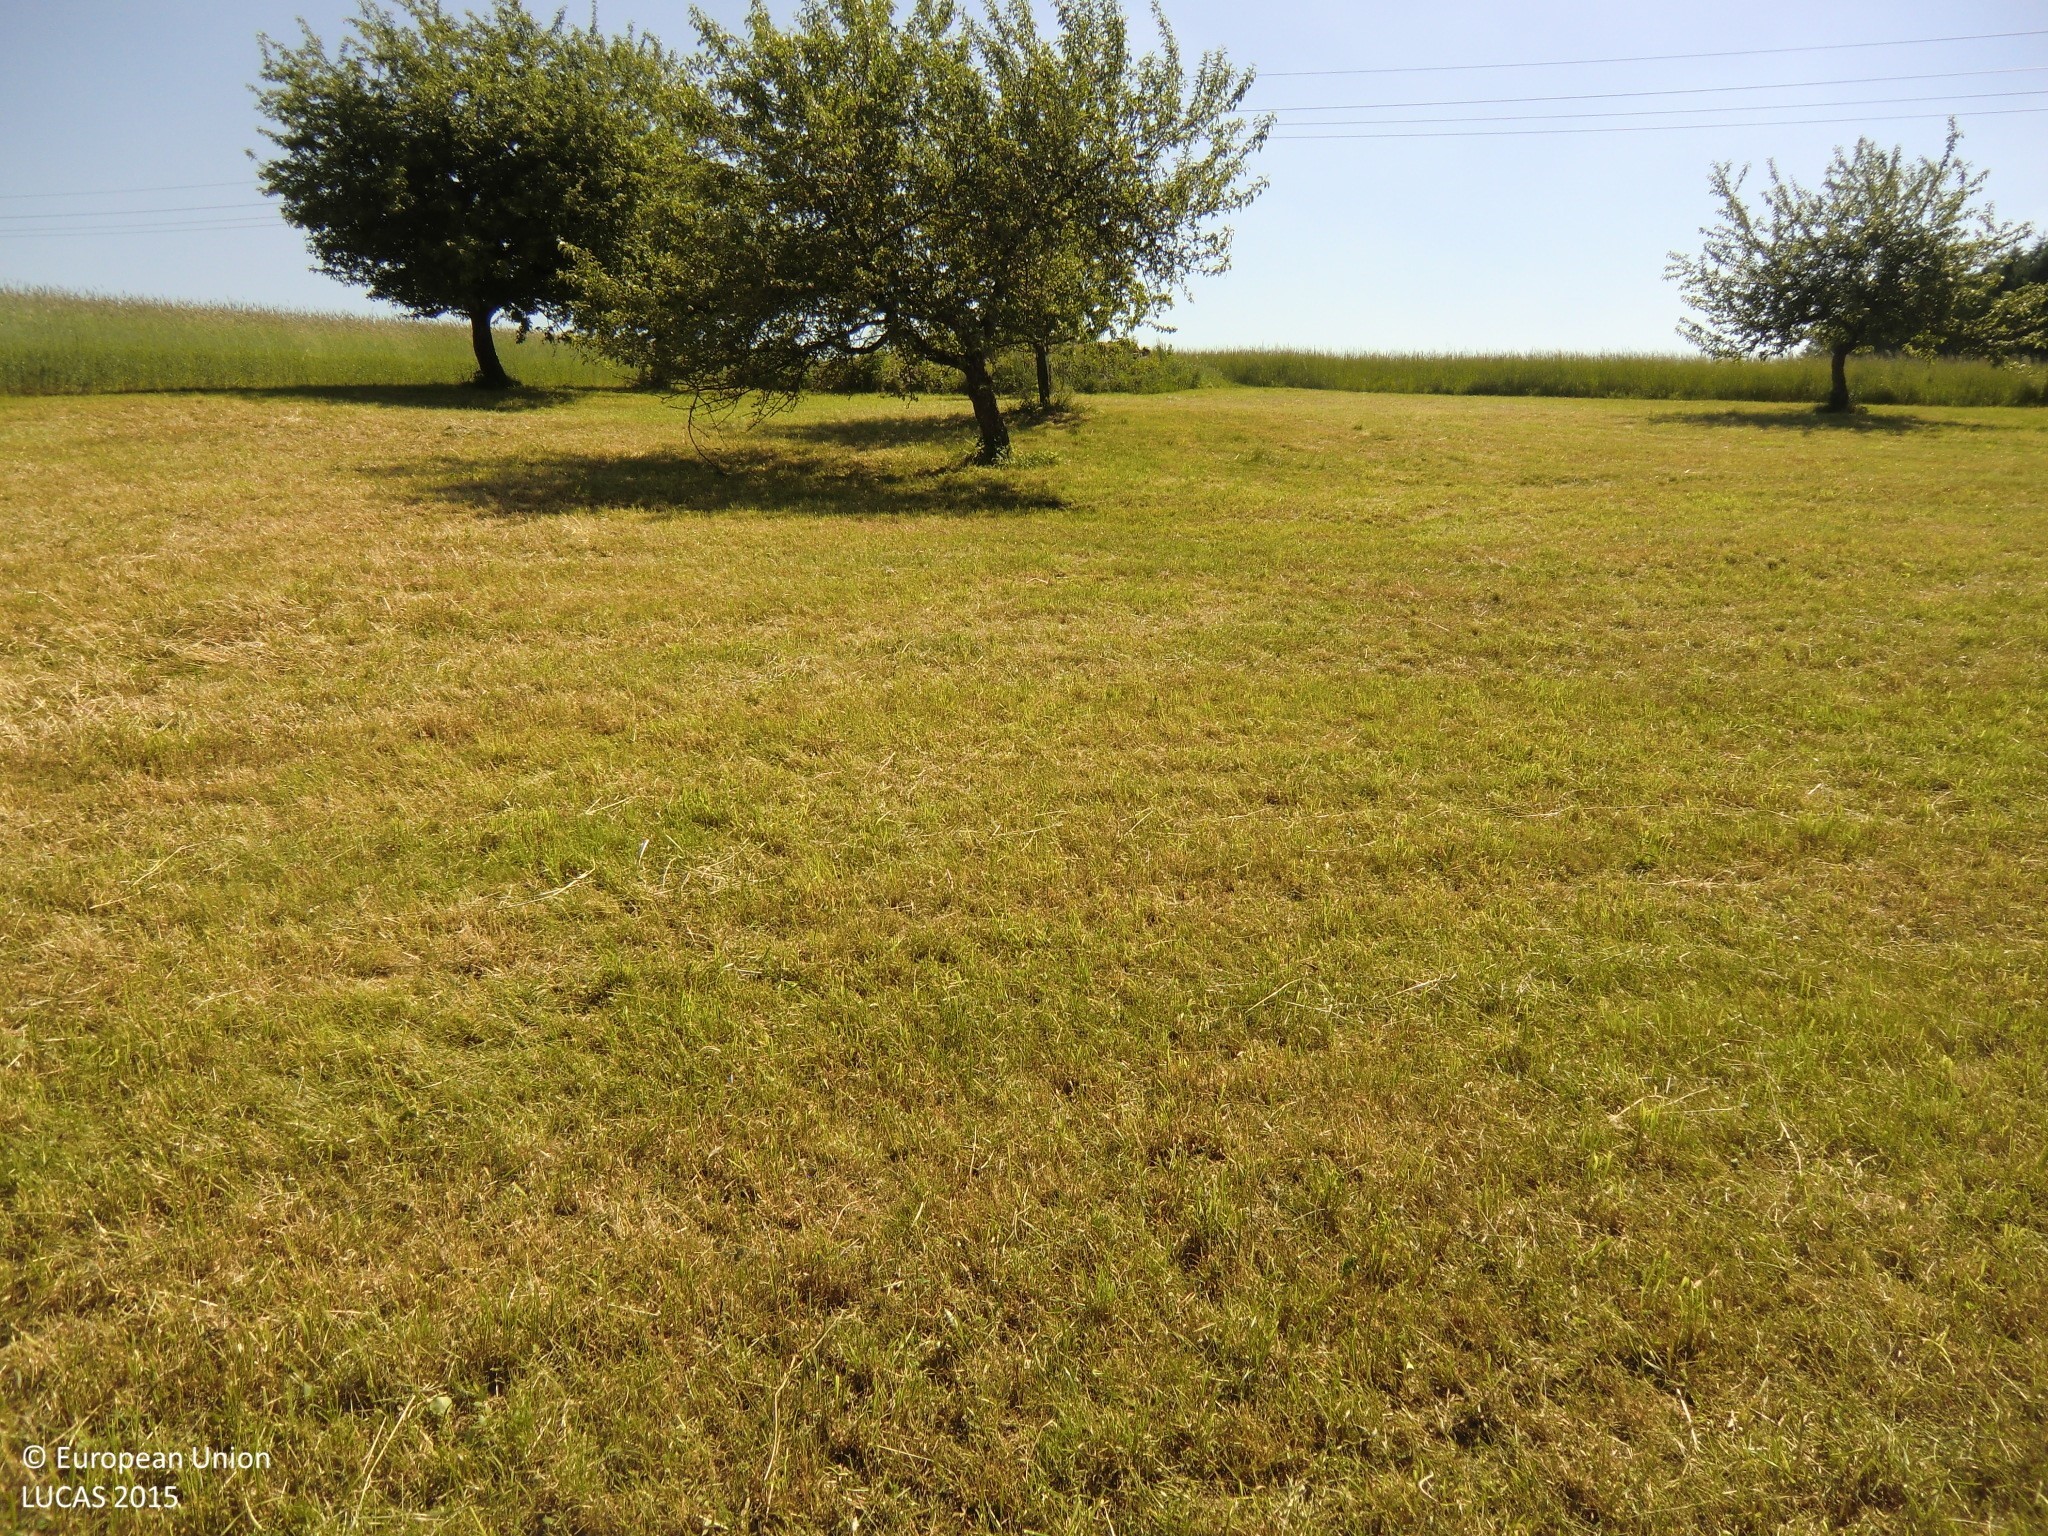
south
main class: Grassland
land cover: Grassland with sparse tree/shrub cover
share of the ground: > 75 %
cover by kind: herbaceous plants 95 %, broadleaved forest trees 5 %
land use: Agriculture (excluding fallow land and kitchen gardens)
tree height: > 5 m
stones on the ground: < 10 %
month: June
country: AT
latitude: 48.5321
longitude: 14.4018
